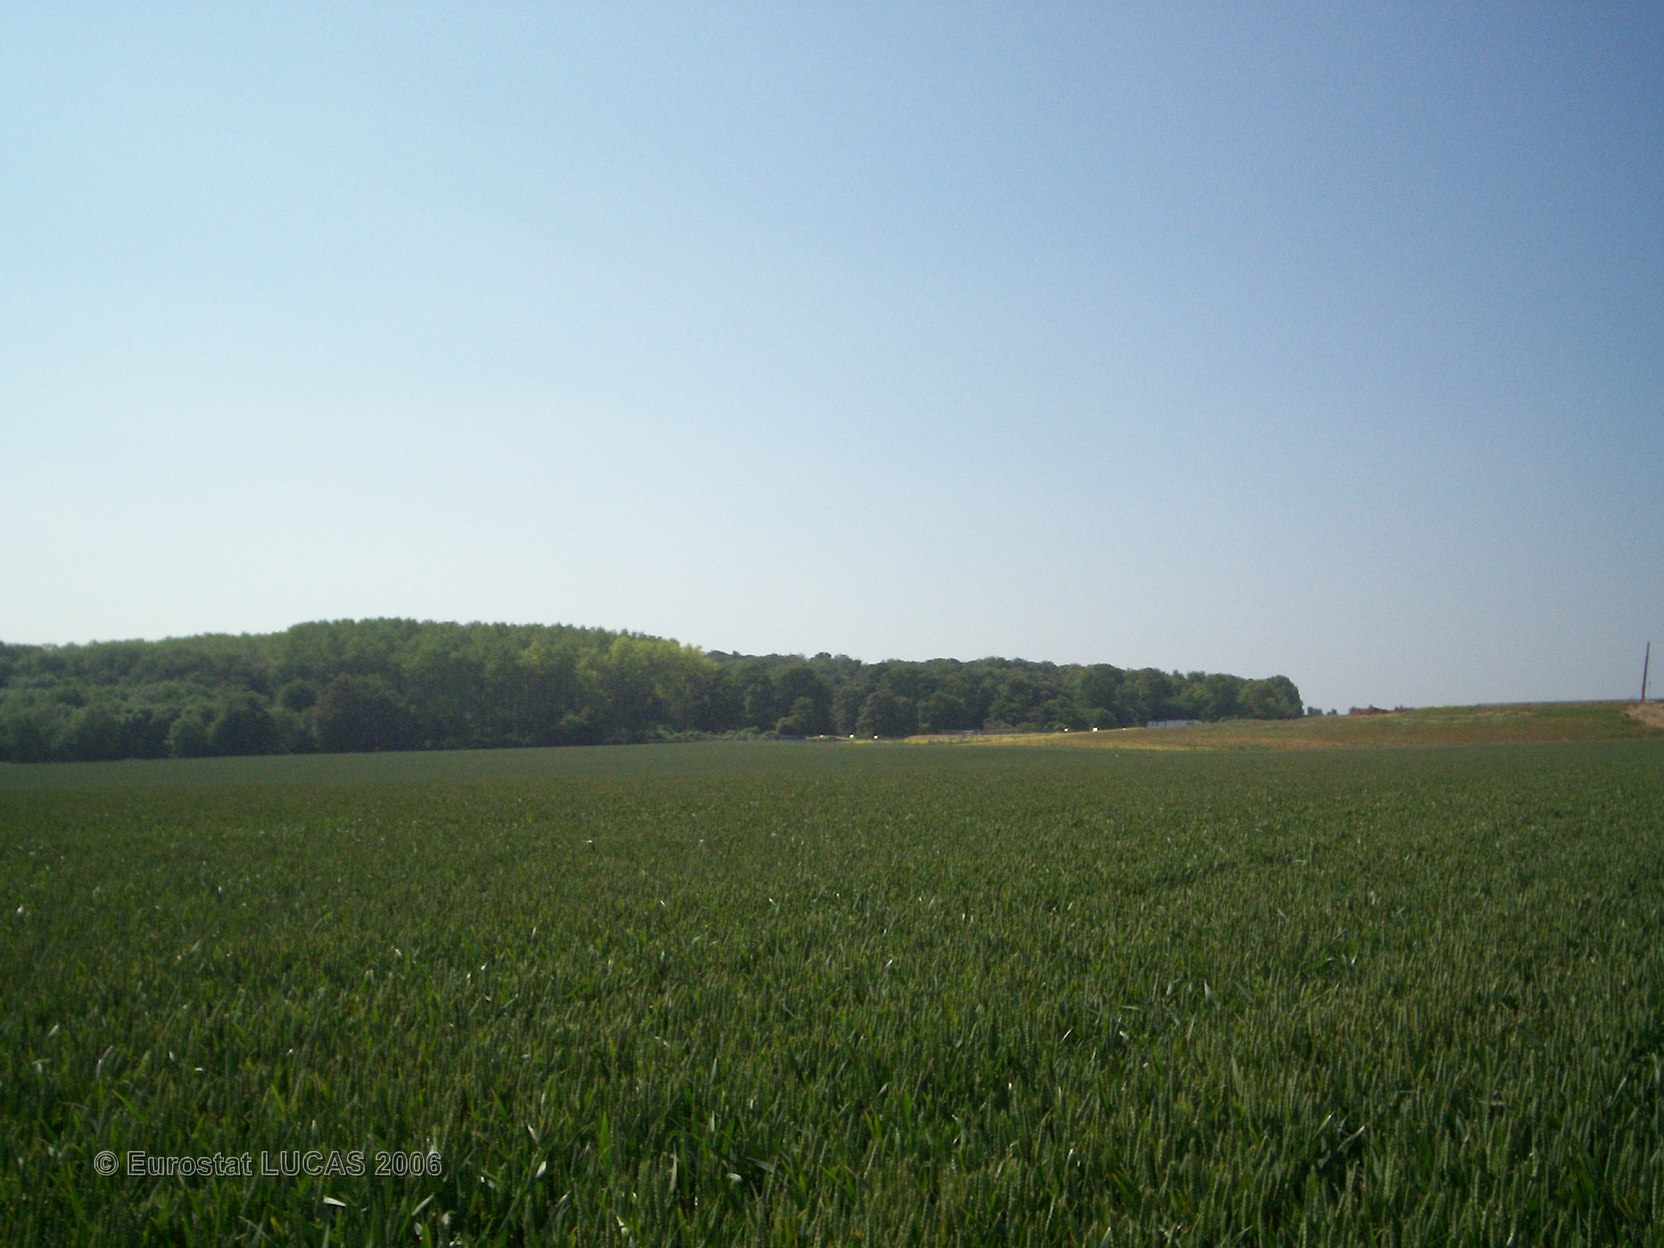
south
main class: Cropland
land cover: Common wheat
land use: Agriculture (excluding fallow land and kitchen gardens)
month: June
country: FR
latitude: 49.5352
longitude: 2.7070
